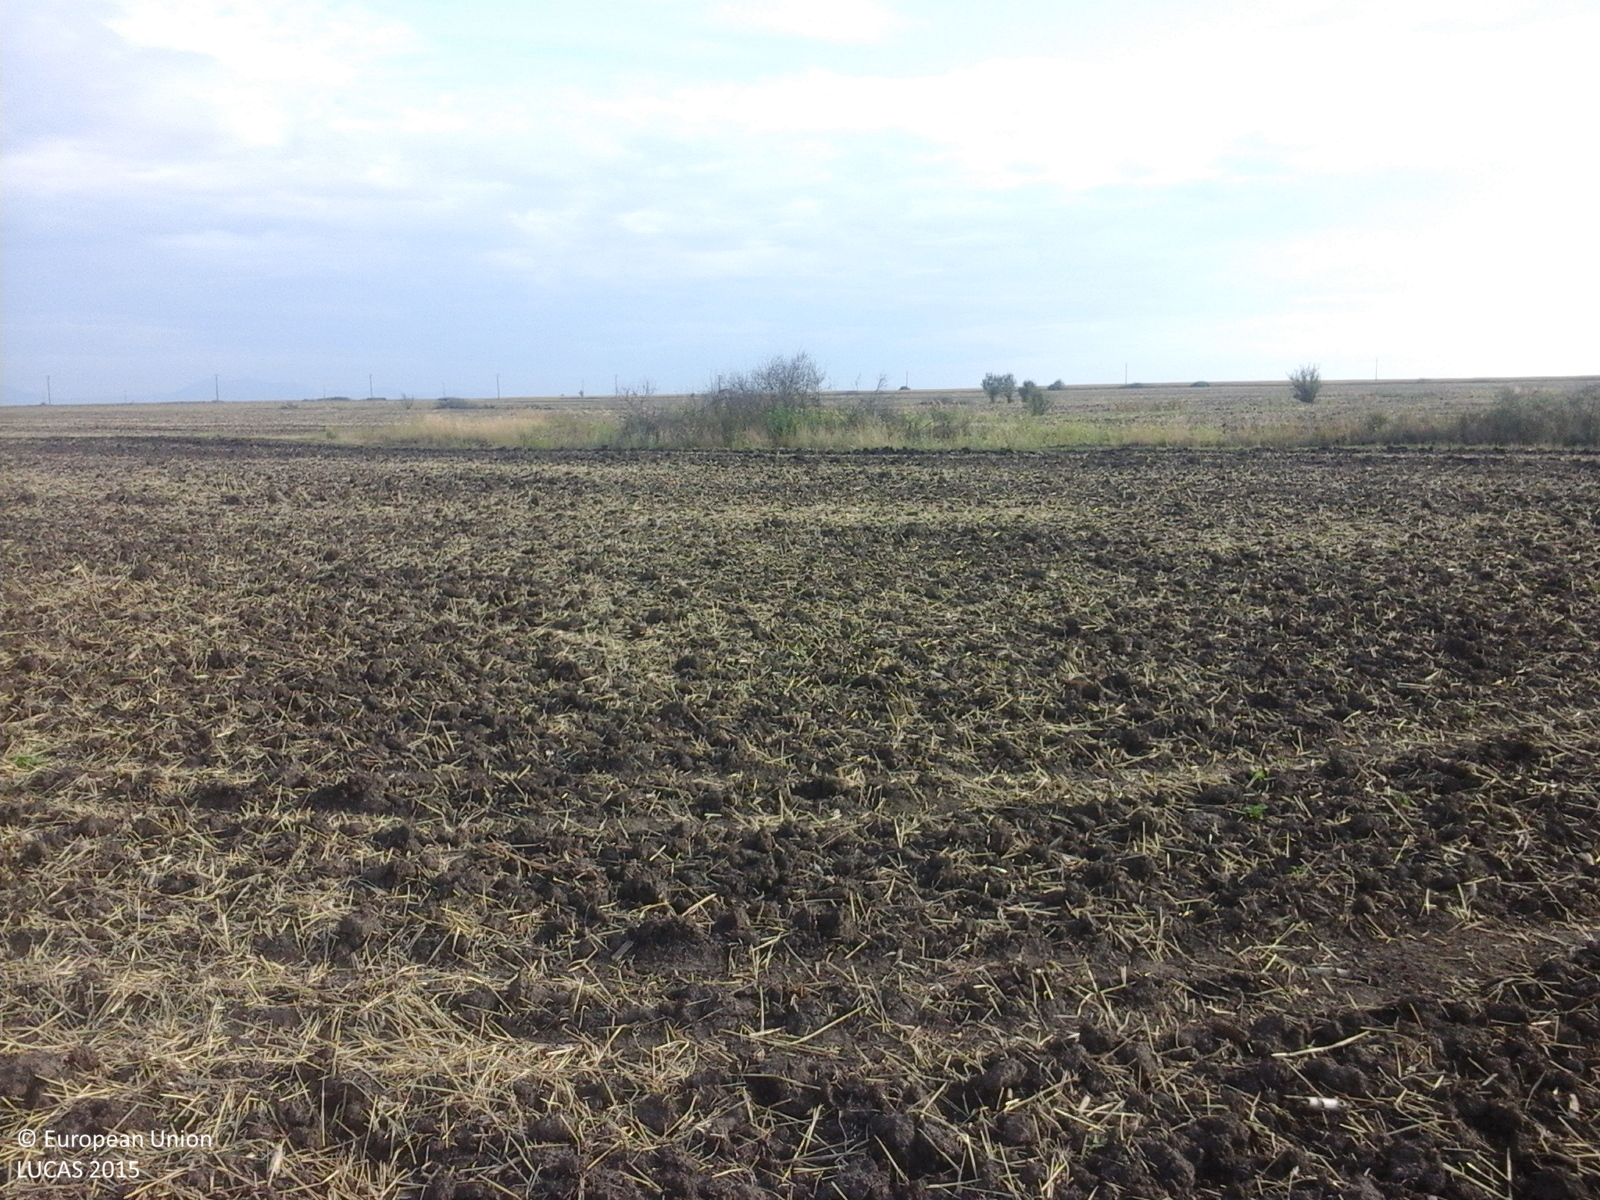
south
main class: Cropland
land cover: Common wheat
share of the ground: < 10 %
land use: Agriculture (excluding fallow land and kitchen gardens)
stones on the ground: < 10 %
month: August
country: RO
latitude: 45.3504
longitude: 21.2996
